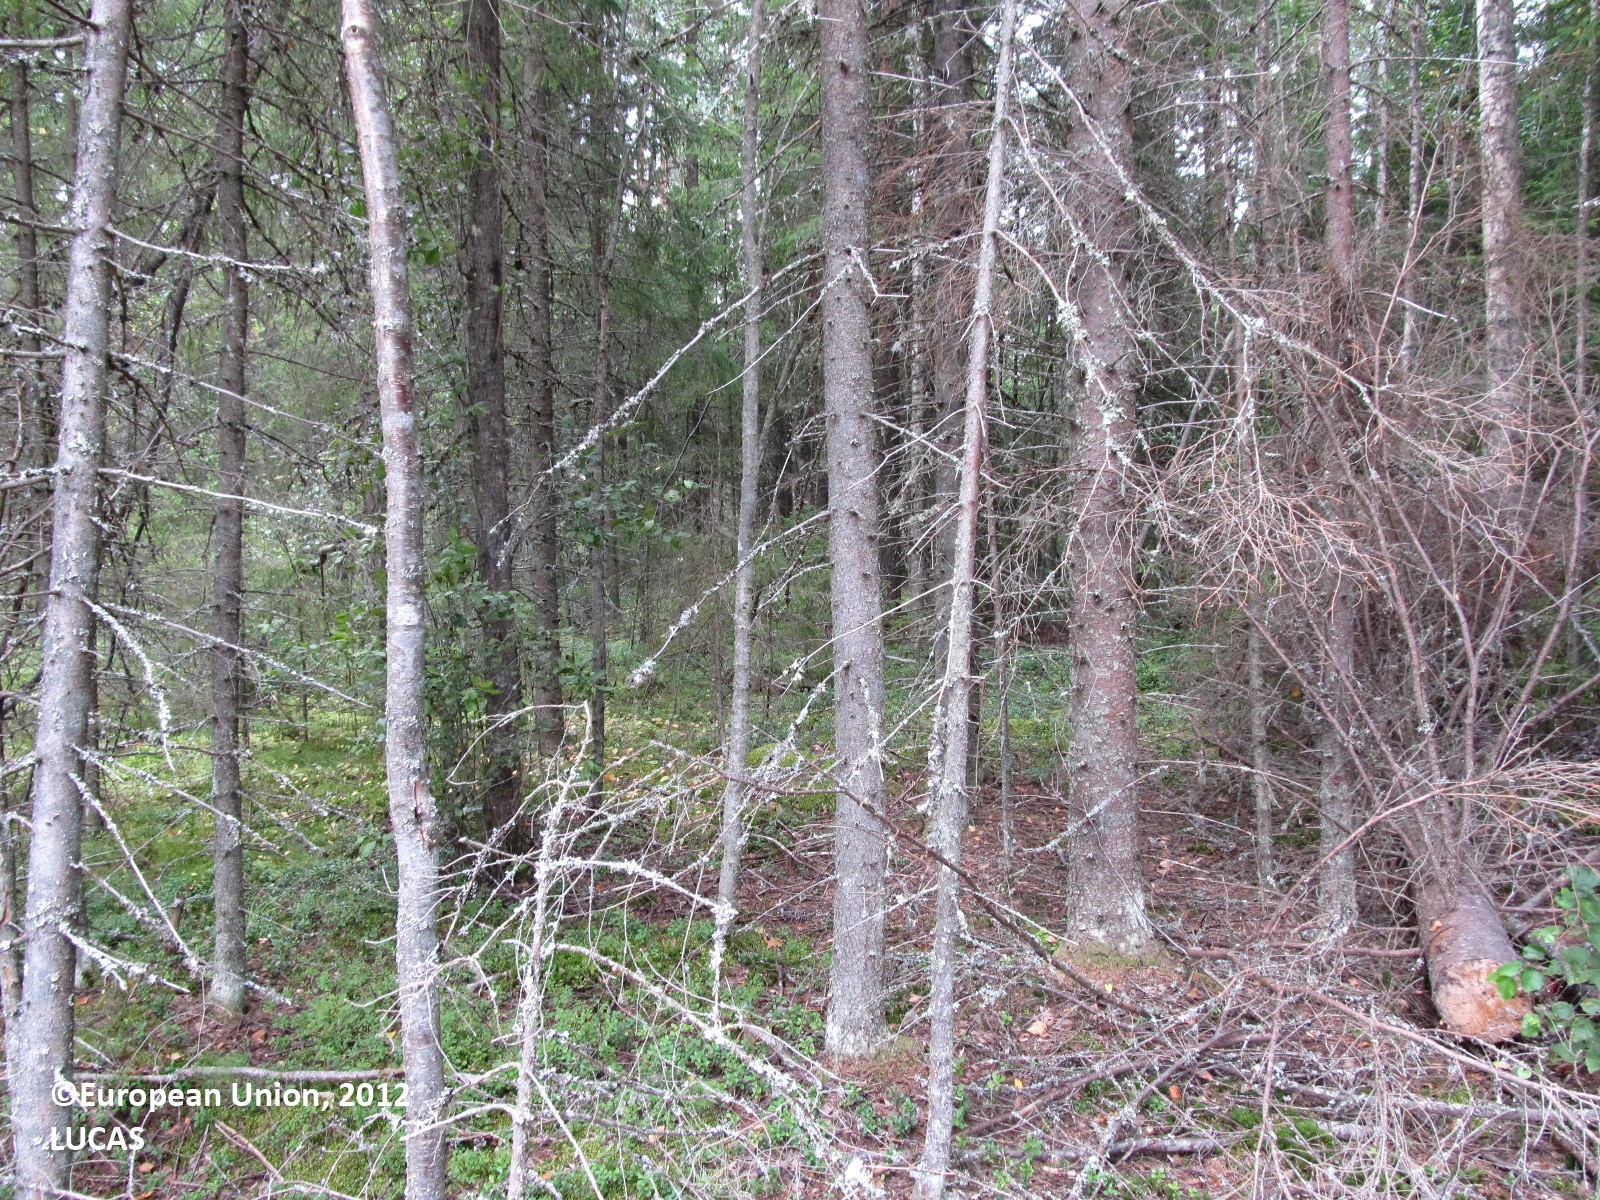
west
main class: Woodland
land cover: Pine dominated mixed woodland
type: boreal forest
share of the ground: 25 - 50 %
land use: Forestry
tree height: > 5 m
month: August
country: FI
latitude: 62.0542
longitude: 27.5216
